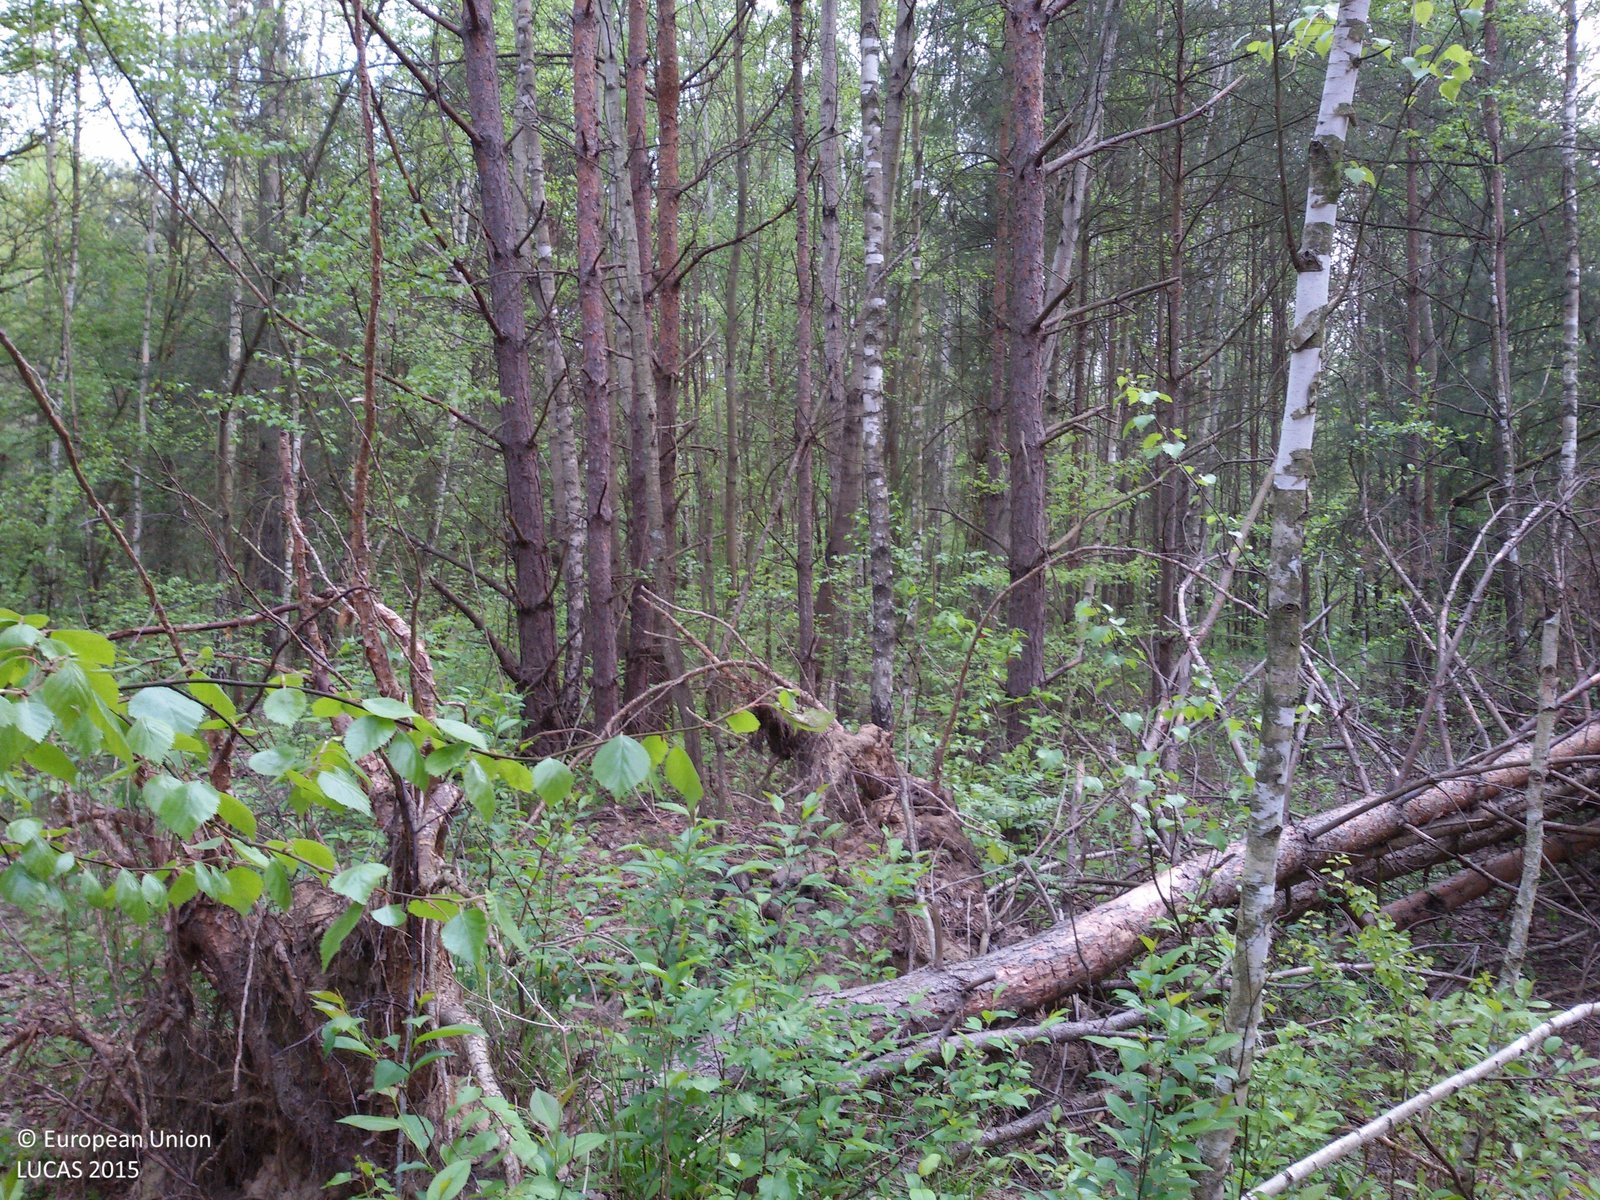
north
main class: Woodland
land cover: Pine dominated mixed woodland
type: hemiboreal forest and nemoral coniferous forest and mixed broadleaved-coniferous forest
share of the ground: > 75 %
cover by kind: coniferous forest trees 70 %, broadleaved forest trees 30 %
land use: Forestry
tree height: > 5 m
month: May
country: PL
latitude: 52.1035
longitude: 20.7722
